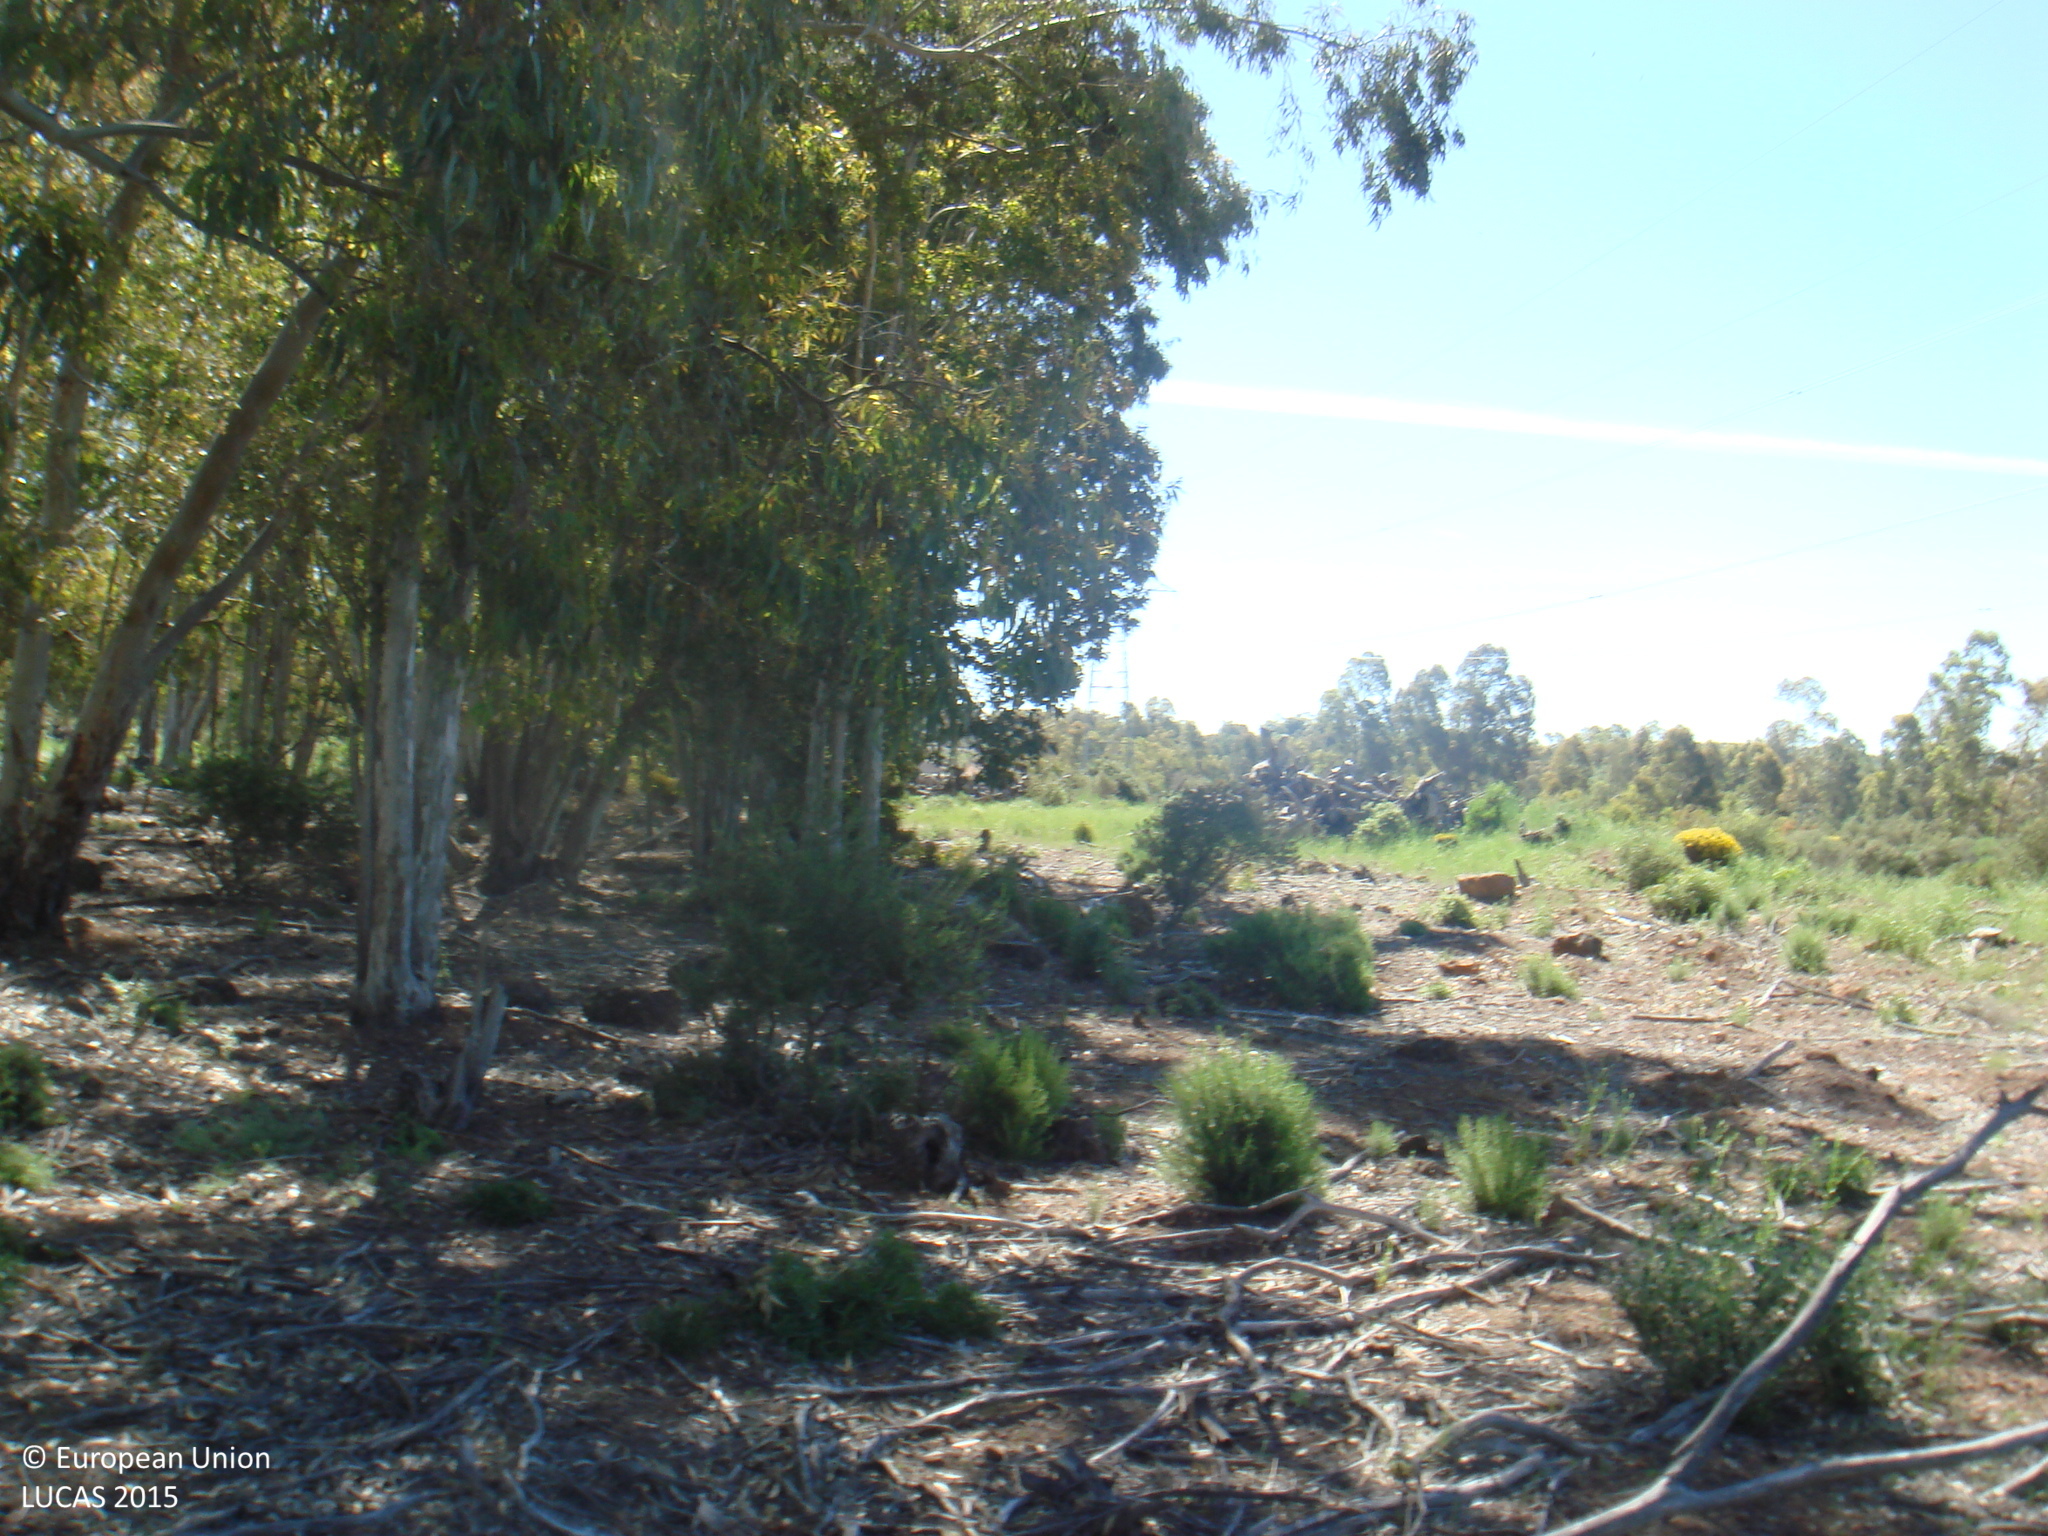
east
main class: Woodland
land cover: Broadleaved woodland
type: broadleaved evergreen forest
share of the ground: > 75 %
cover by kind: broadleaved forest trees 50 %, herbaceous plants 30 %, shrubs 20 %
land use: Forestry
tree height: > 5 m
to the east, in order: Broadleaved woodland; Spontaneously vegetated surfaces; Broadleaved woodland; Lines of trees; Tracks; Lines of trees; Tracks; Lines of trees; Grassland with sparse tree/shrub cover
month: May
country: ES
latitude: 38.4575
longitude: -4.4468
